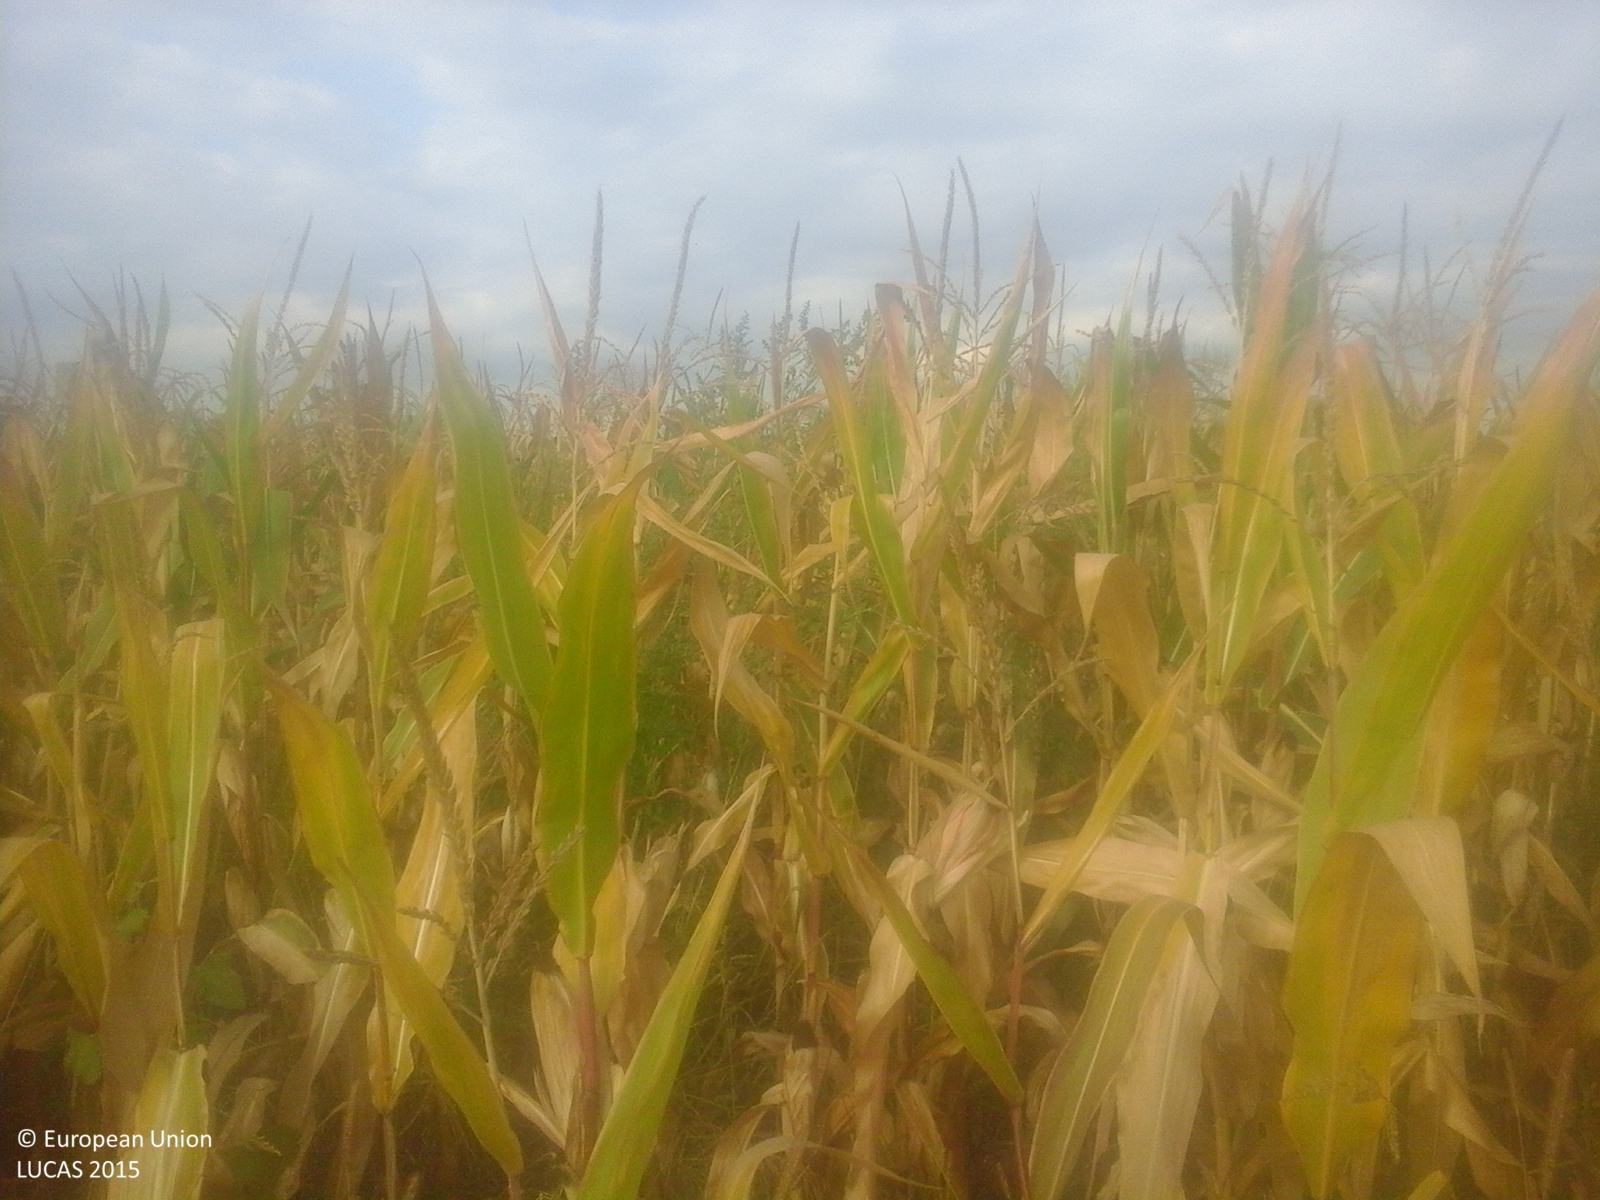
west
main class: Cropland
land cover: Maize
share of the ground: > 75 %
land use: Agriculture (excluding fallow land and kitchen gardens)
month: September
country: RO
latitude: 47.7915
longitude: 22.7304
